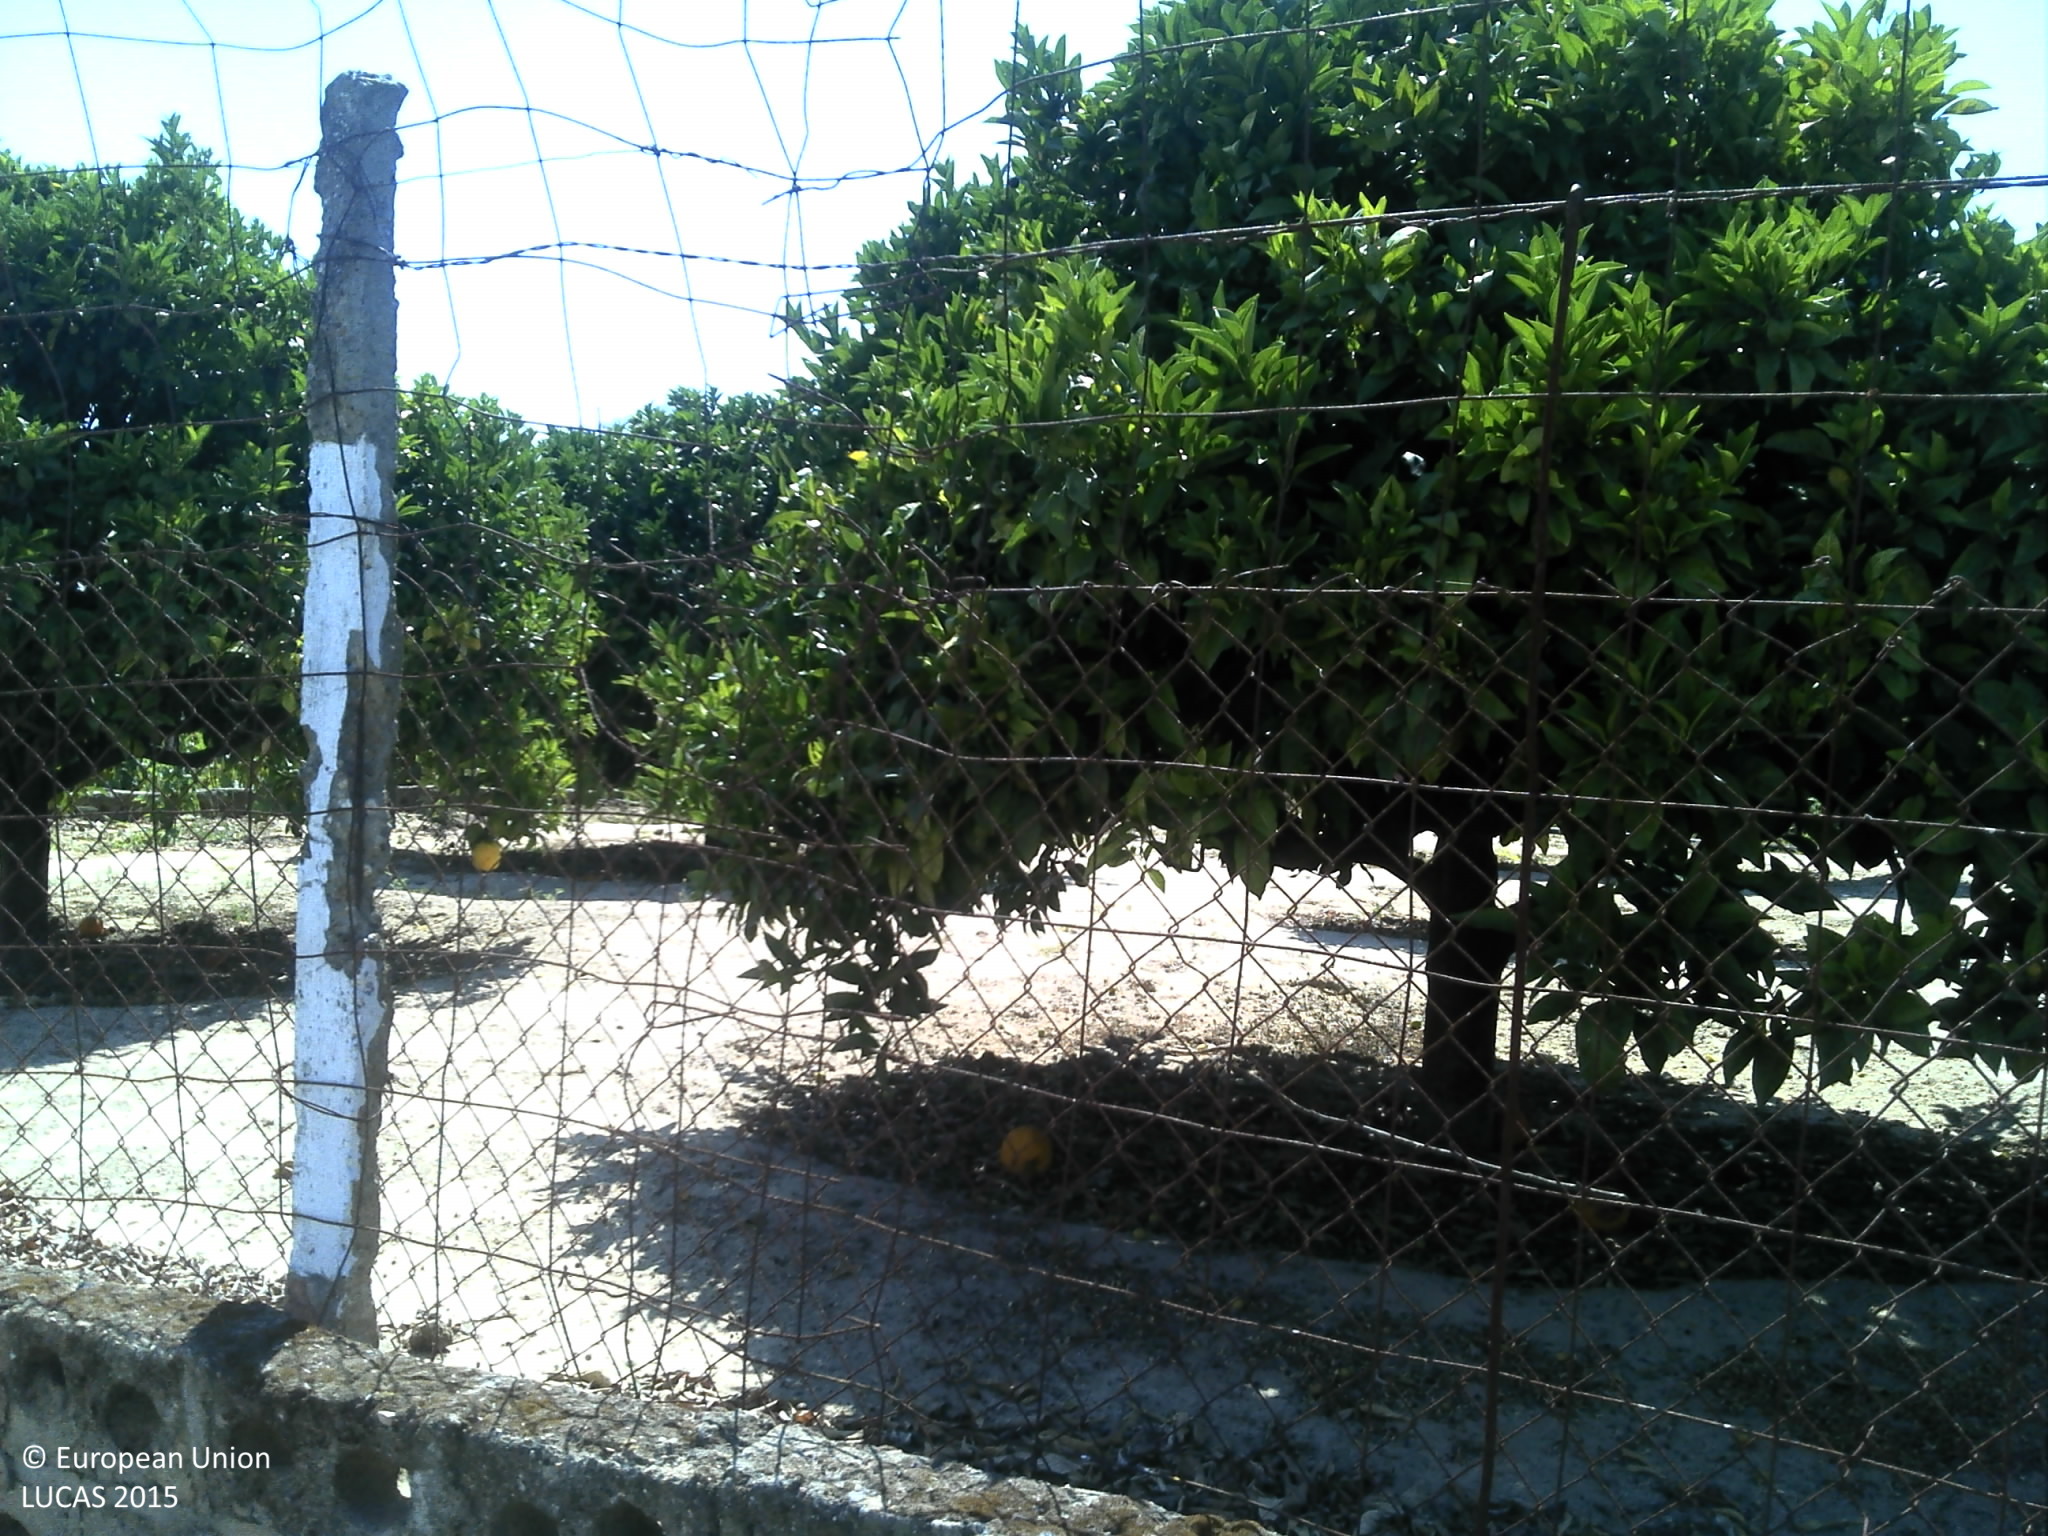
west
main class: Cropland
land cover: Oranges
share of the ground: 50 - 75 %
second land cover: Other bare soil
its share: > 75 %
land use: Agriculture (excluding fallow land and kitchen gardens)
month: June
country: PT
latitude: 39.0470
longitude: -8.6829
